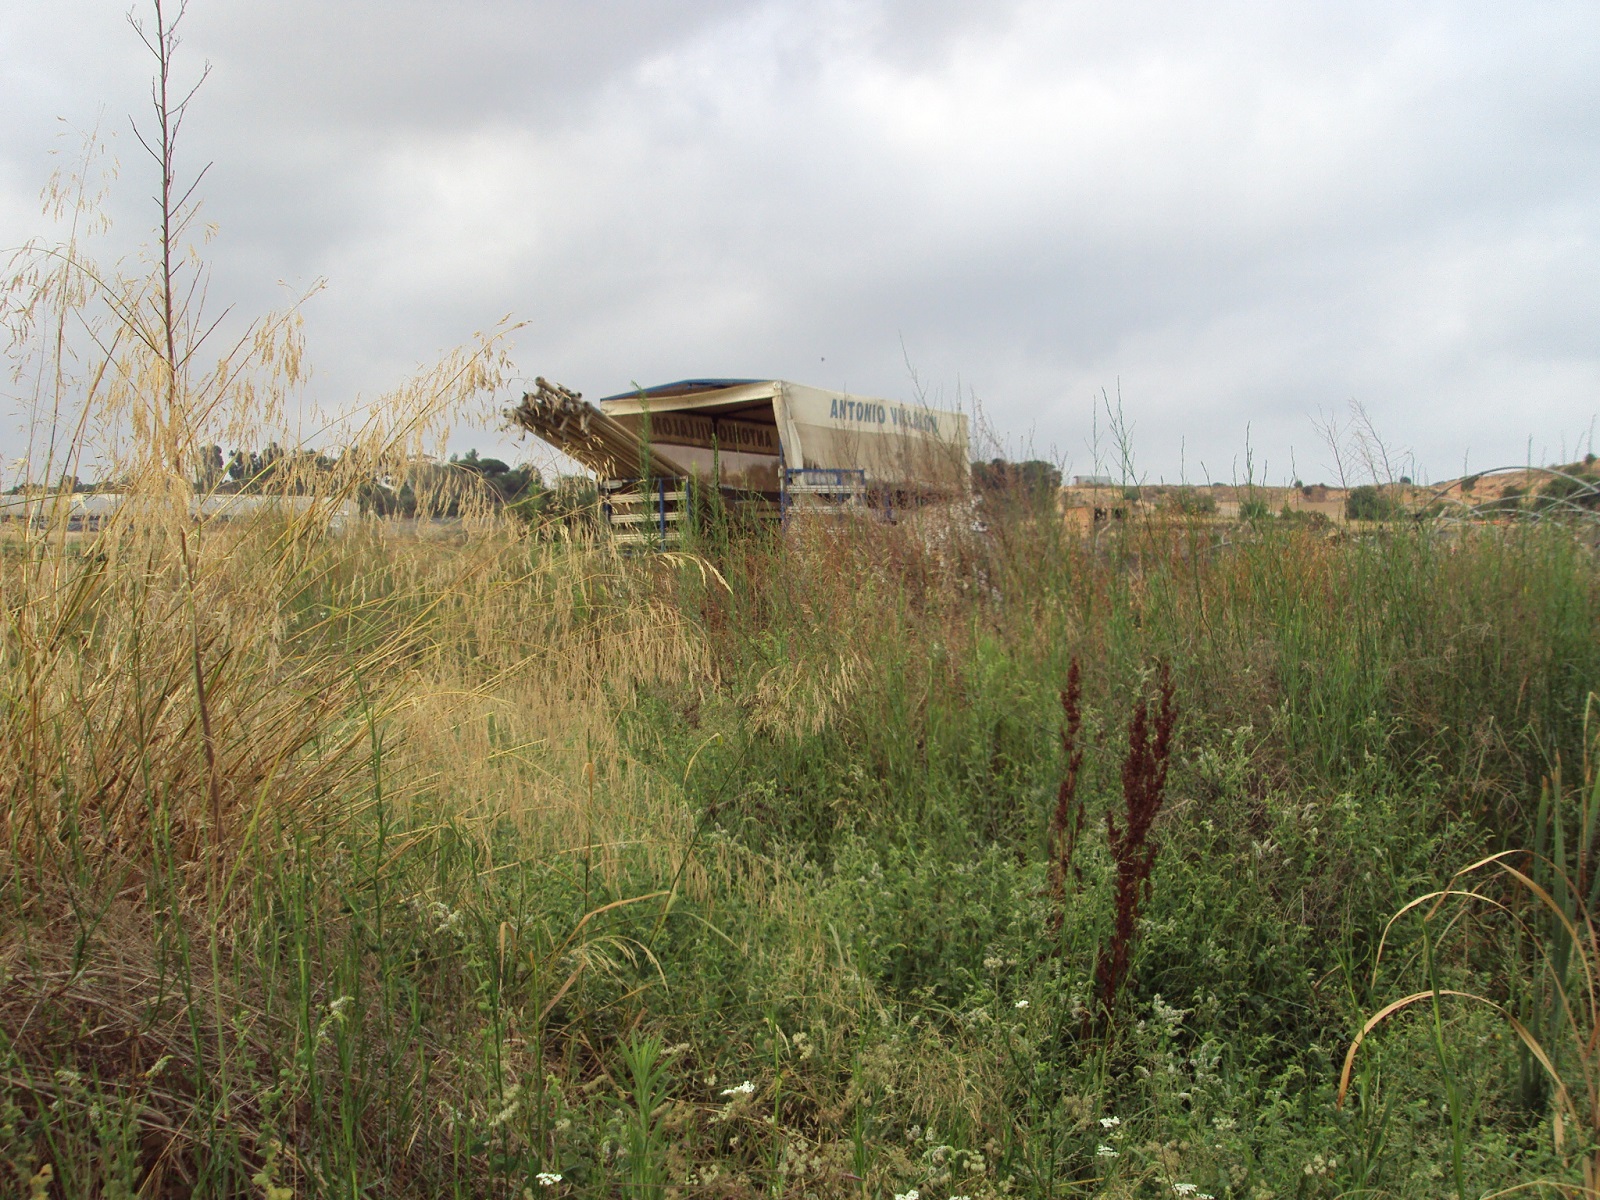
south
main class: Grassland
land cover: Spontaneously vegetated surfaces
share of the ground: > 75 %
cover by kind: herbaceous plants 100 %
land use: Semi-natural and natural areas not in use
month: June
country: ES
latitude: 37.2193
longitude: -6.9070
